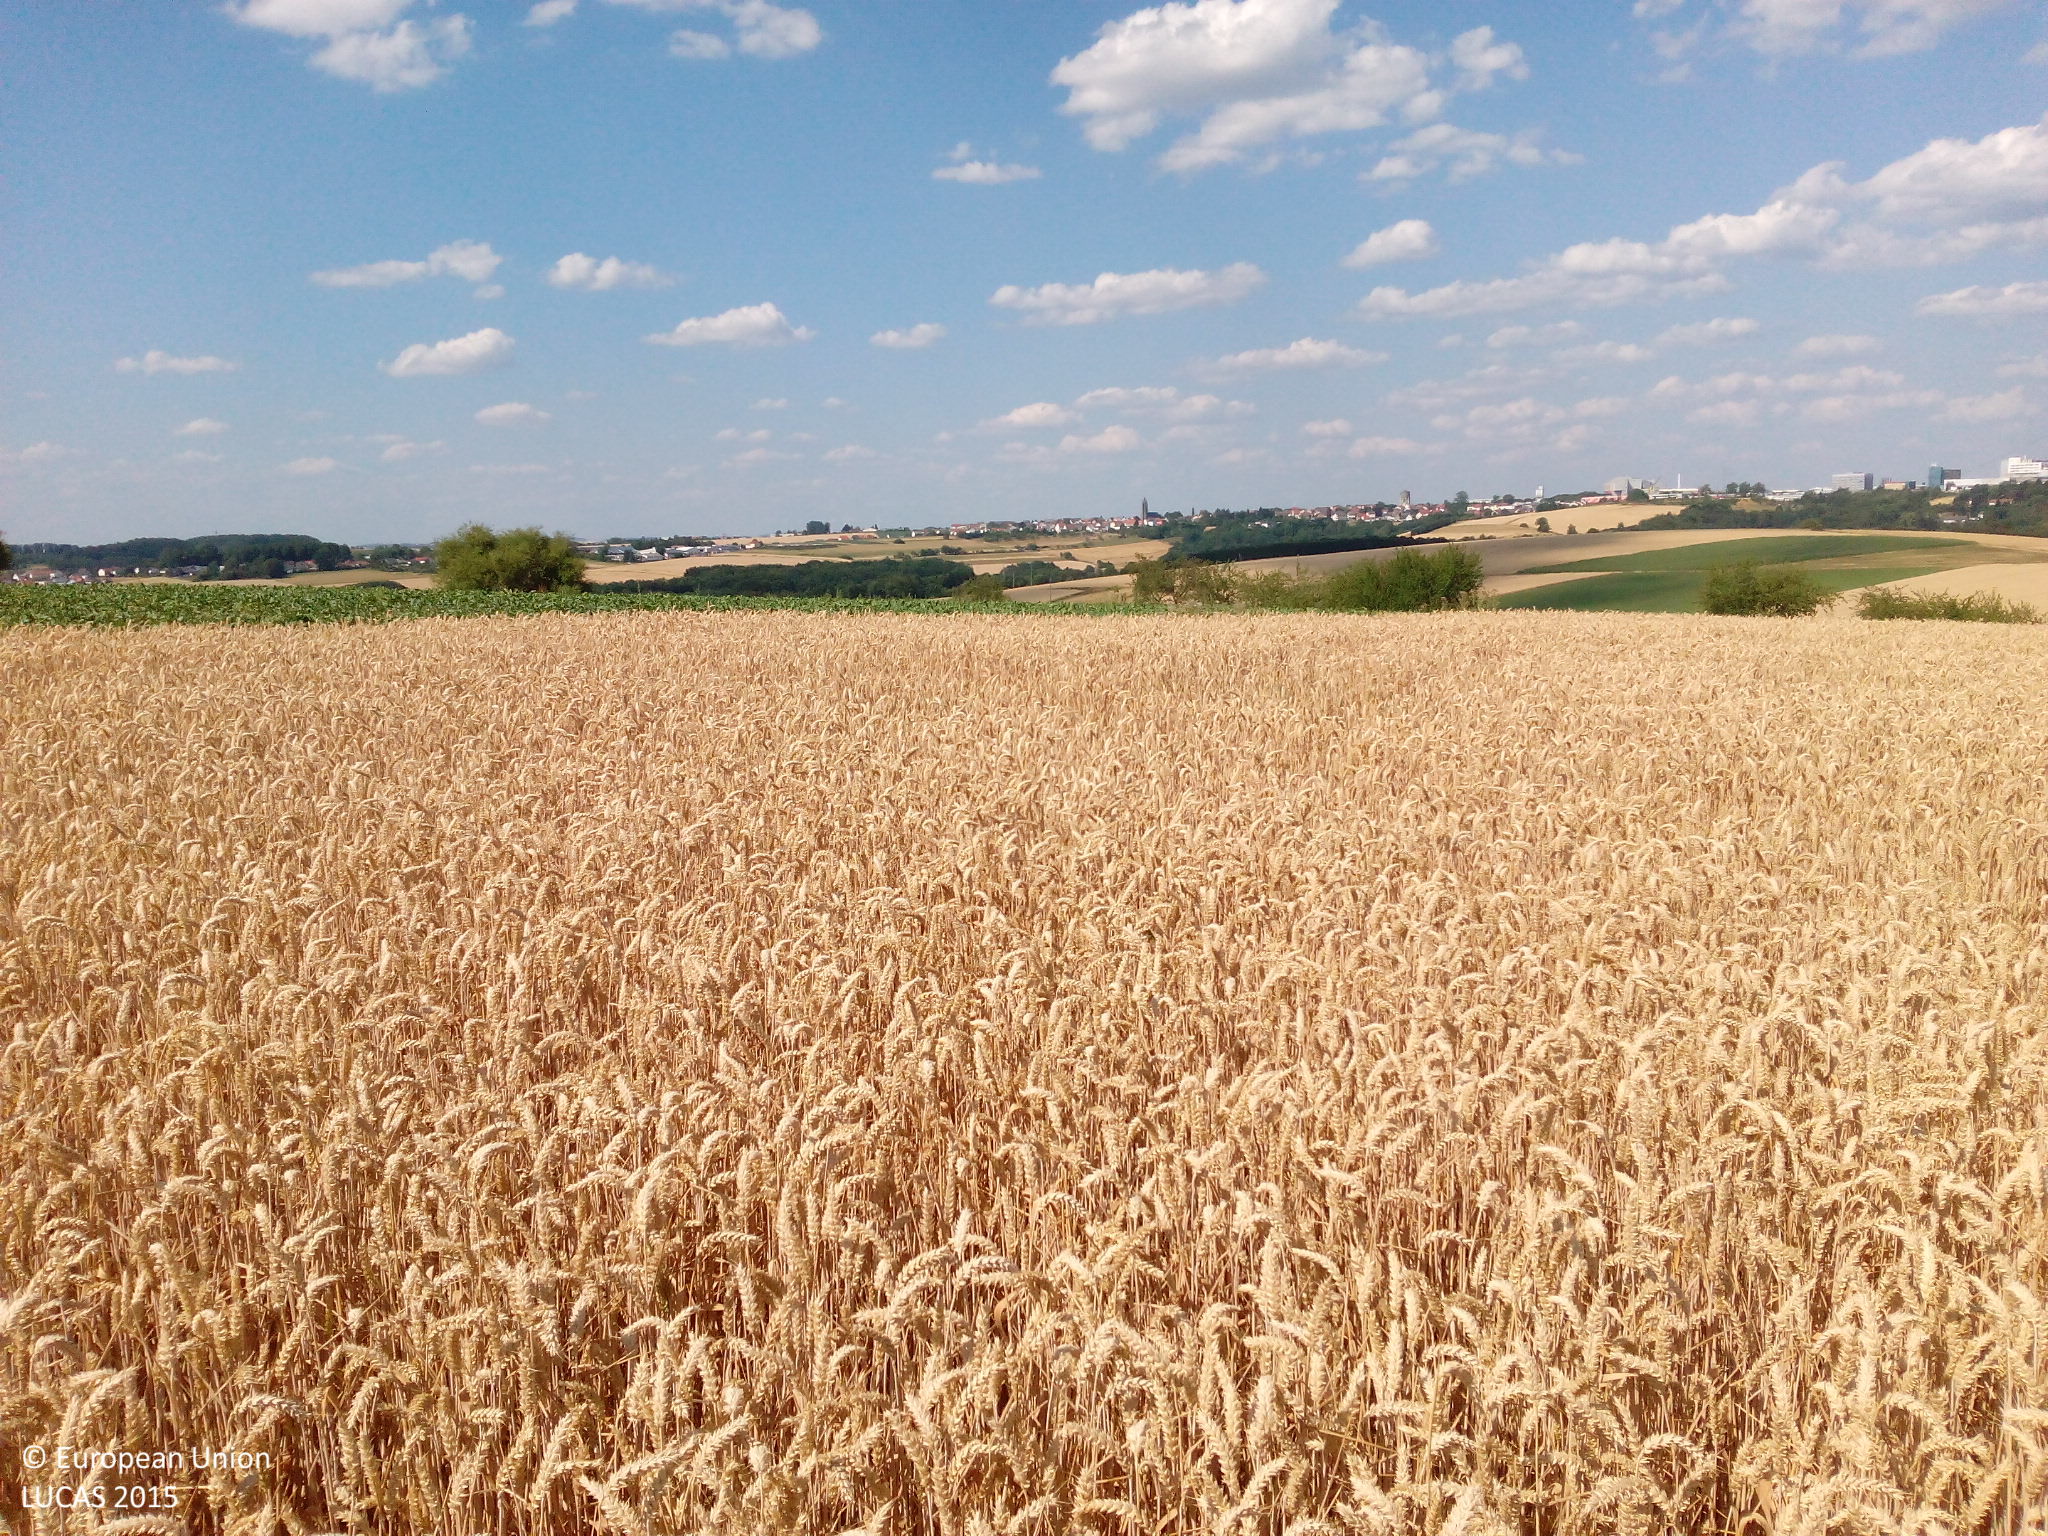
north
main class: Cropland
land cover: Common wheat
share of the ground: > 75 %
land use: Agriculture (excluding fallow land and kitchen gardens)
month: July
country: DE
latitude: 49.2048
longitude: 7.5712
